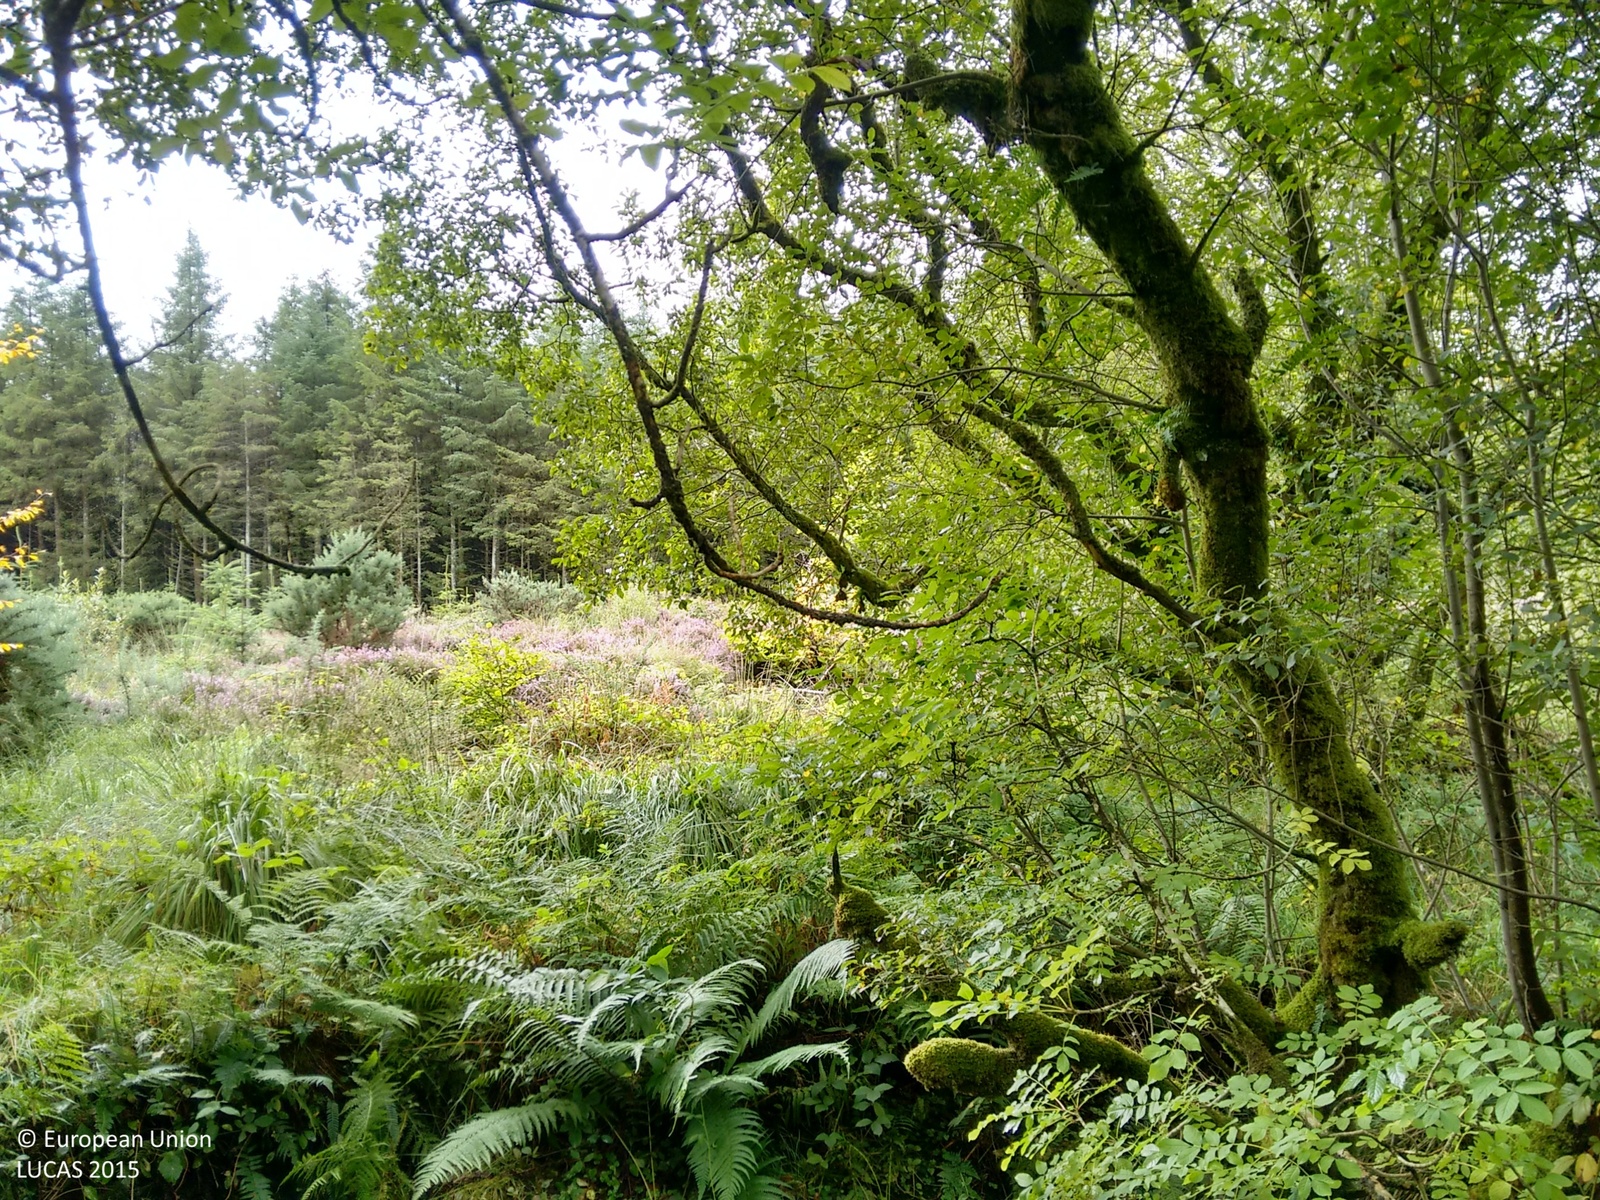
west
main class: Shrubland
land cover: Shrubland with sparse tree cover
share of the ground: > 75 %
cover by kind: shrubs 80 %, herbaceous plants 15 %, coniferous forest trees 5 %
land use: Forestry
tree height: < 5 m
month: September
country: IE
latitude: 52.9288
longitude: -8.7848
